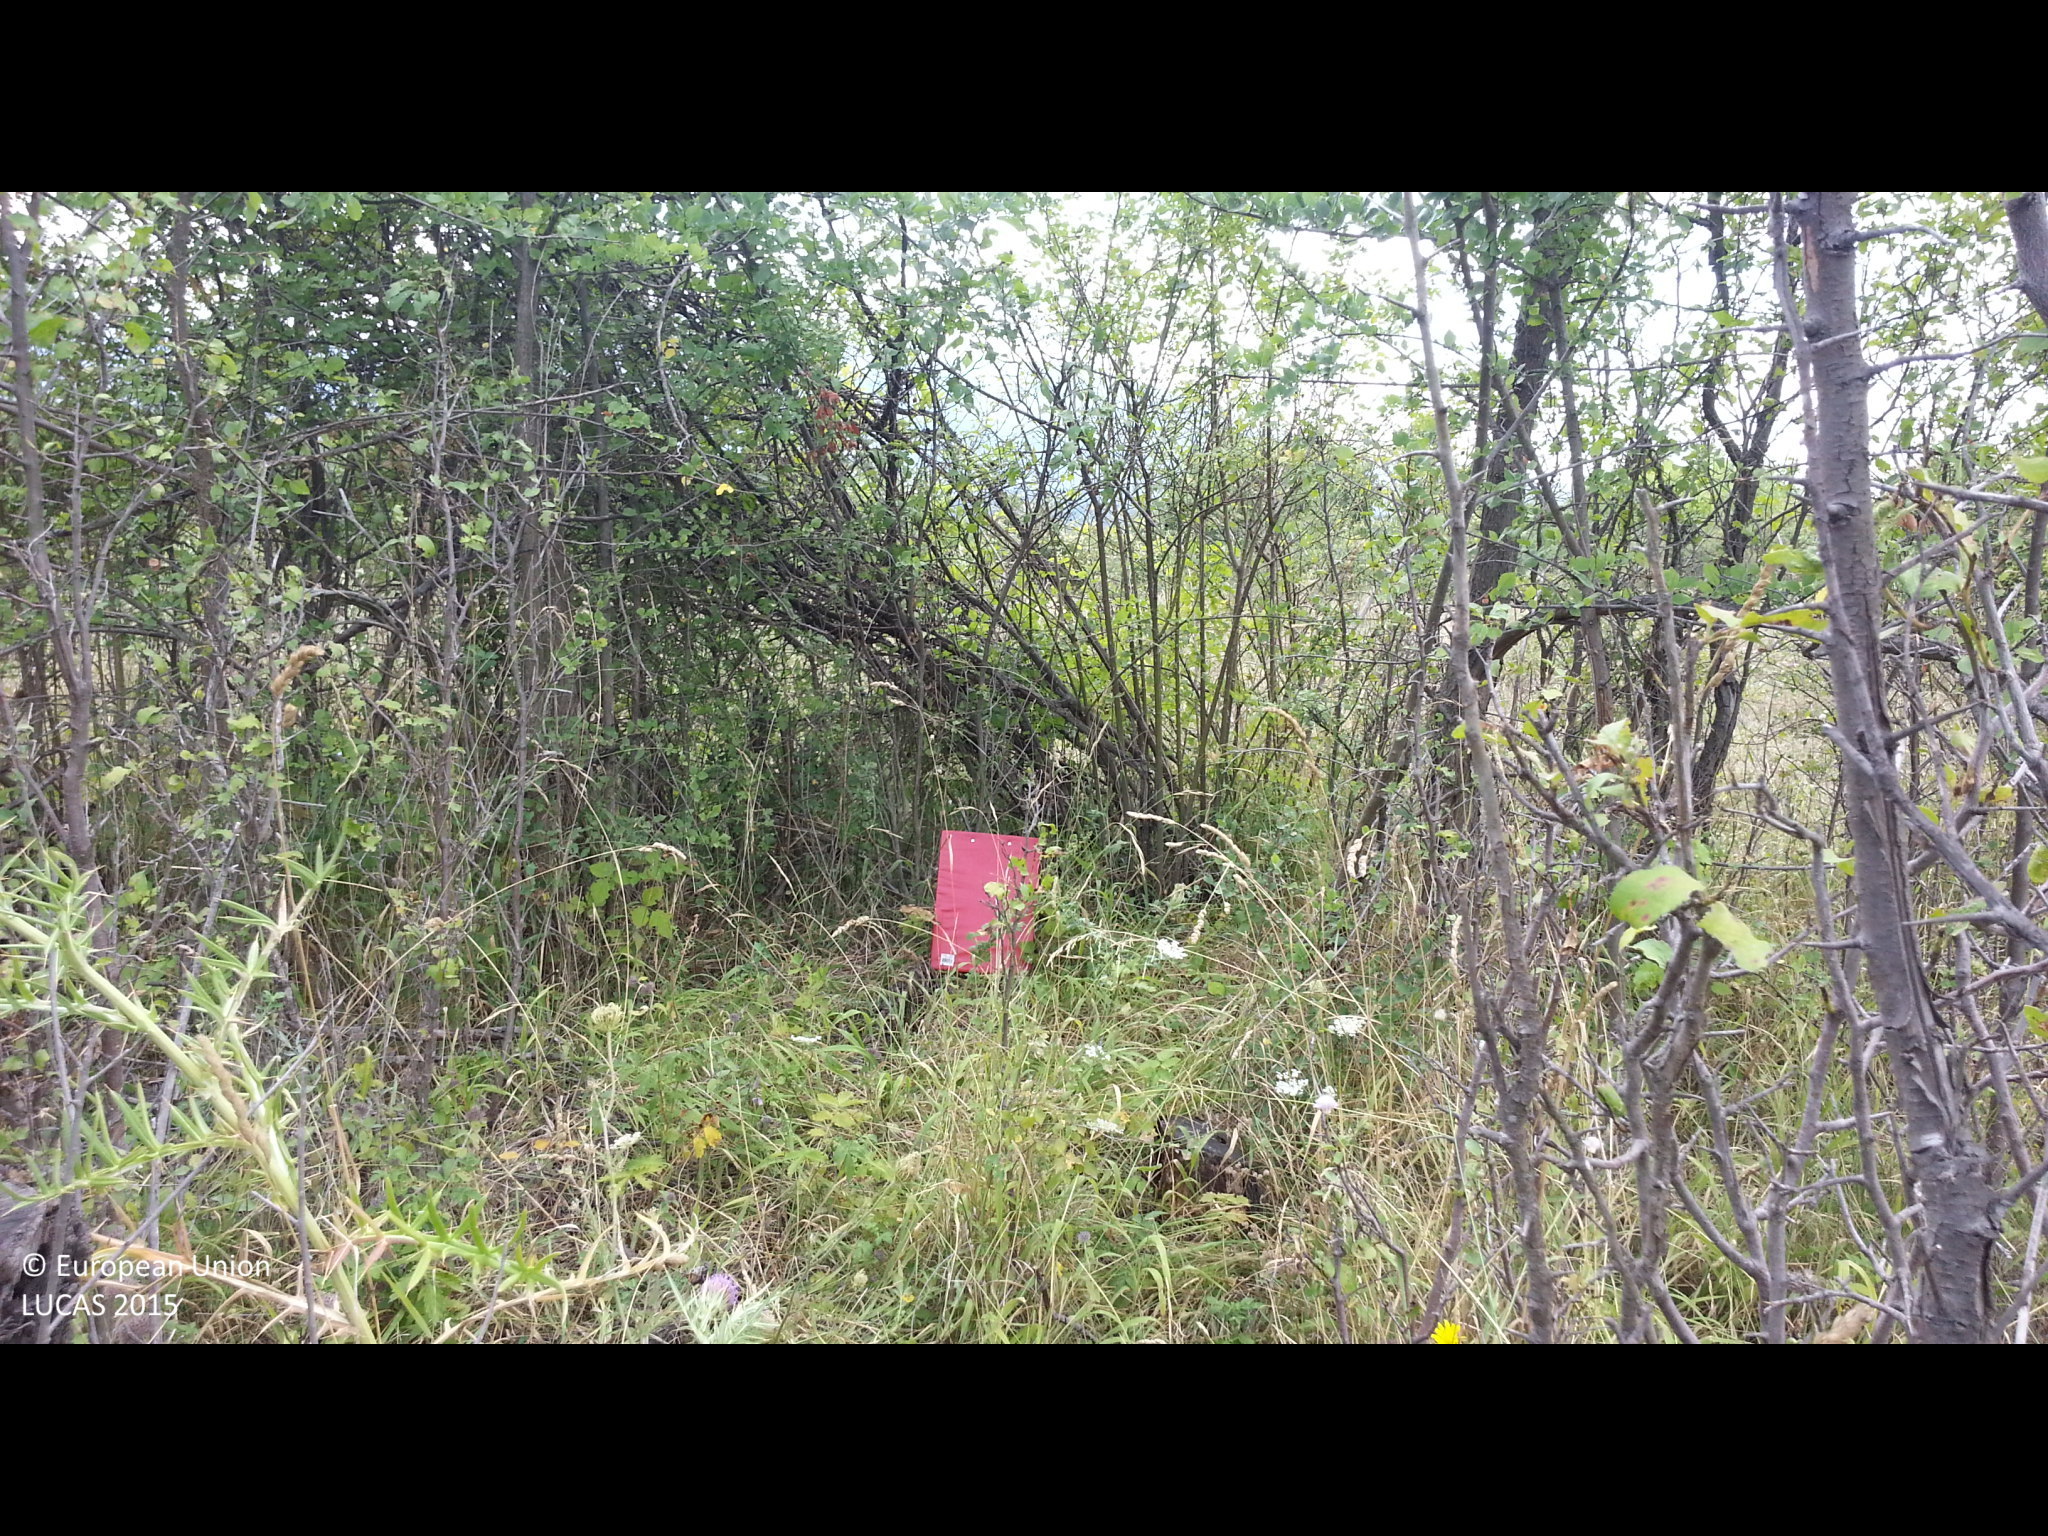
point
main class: Shrubland
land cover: Shrubland with sparse tree cover
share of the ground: > 75 %
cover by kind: herbaceous plants 60 %, shrubs 35 %, broadleaved forest trees 5 %
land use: Abandoned areas
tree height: < 5 m
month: August
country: BG
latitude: 42.2583
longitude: 23.0819
